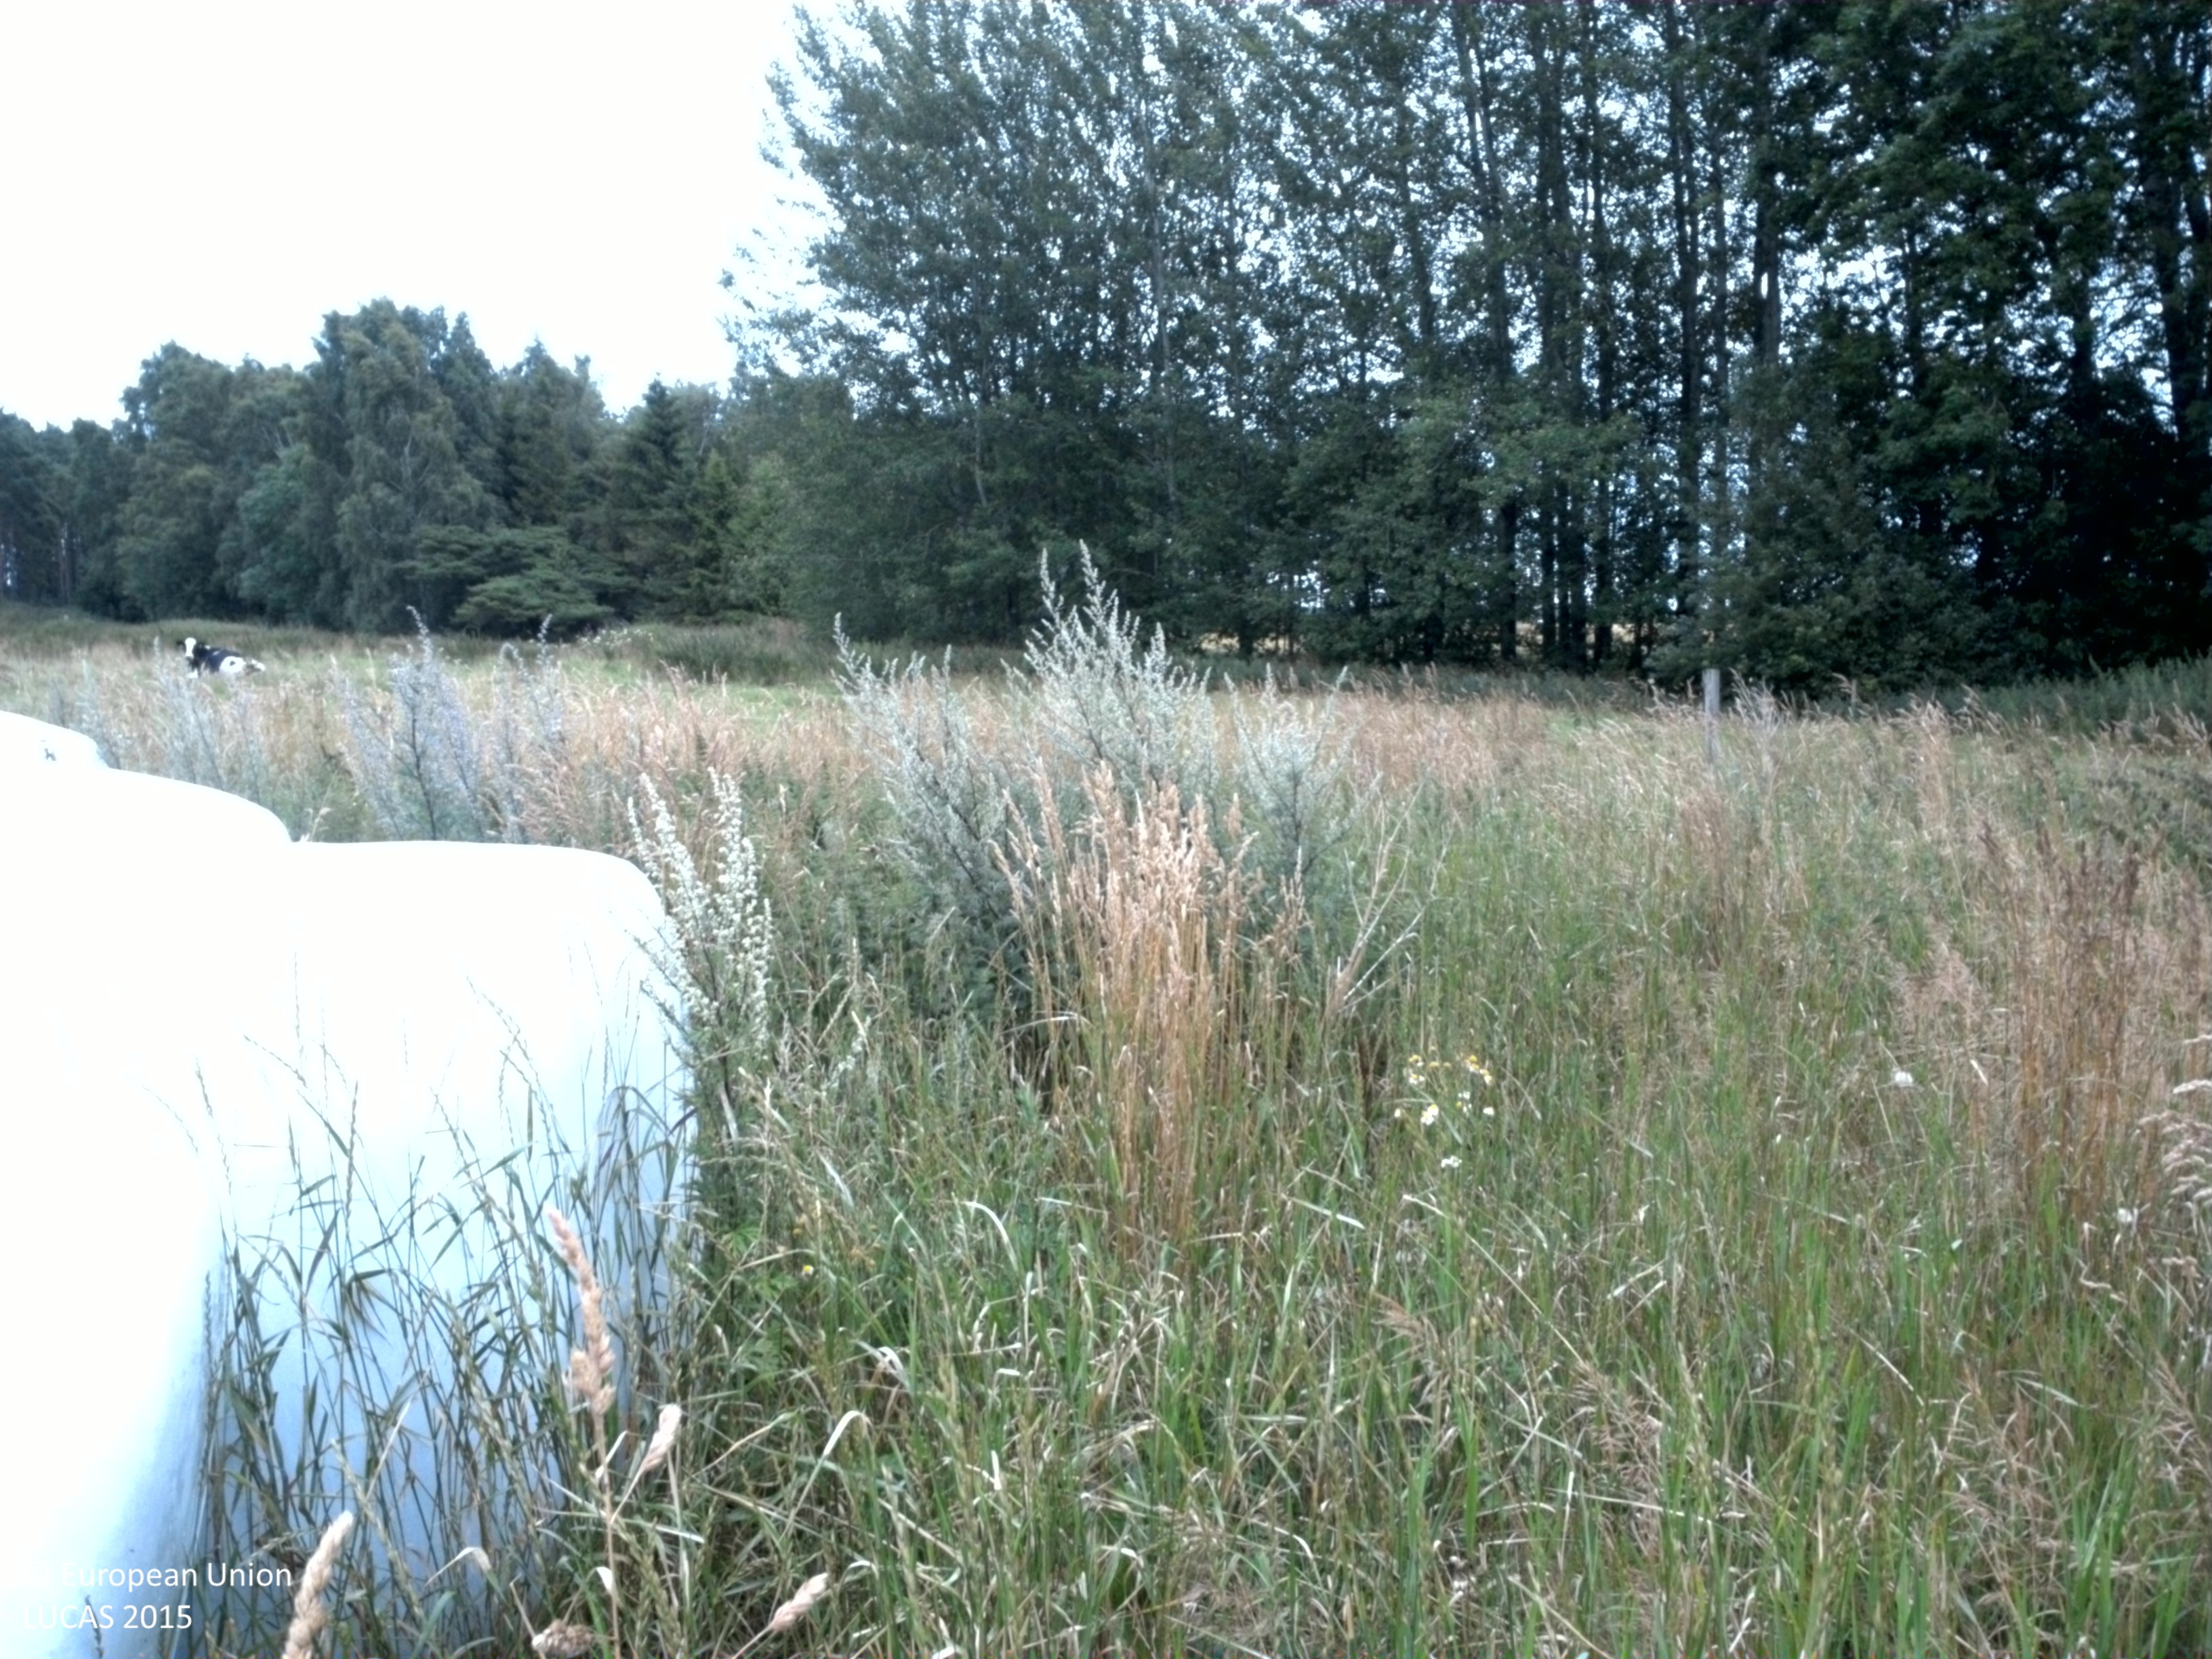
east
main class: Grassland
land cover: Grassland without tree/shrub cover
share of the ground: > 75 %
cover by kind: herbaceous plants 100 %
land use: Agriculture (excluding fallow land and kitchen gardens)
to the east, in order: Grassland without tree/shrub cover; Fences; Grassland without tree/shrub cover; Fences; Rivers and streams; Abandoned hedges; Grassland without tree/shrub cover; Ditches and canals; Spruce dominated coniferous woodland; Broadleaved woodland
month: July
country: SE
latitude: 57.2371
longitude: 18.6092
